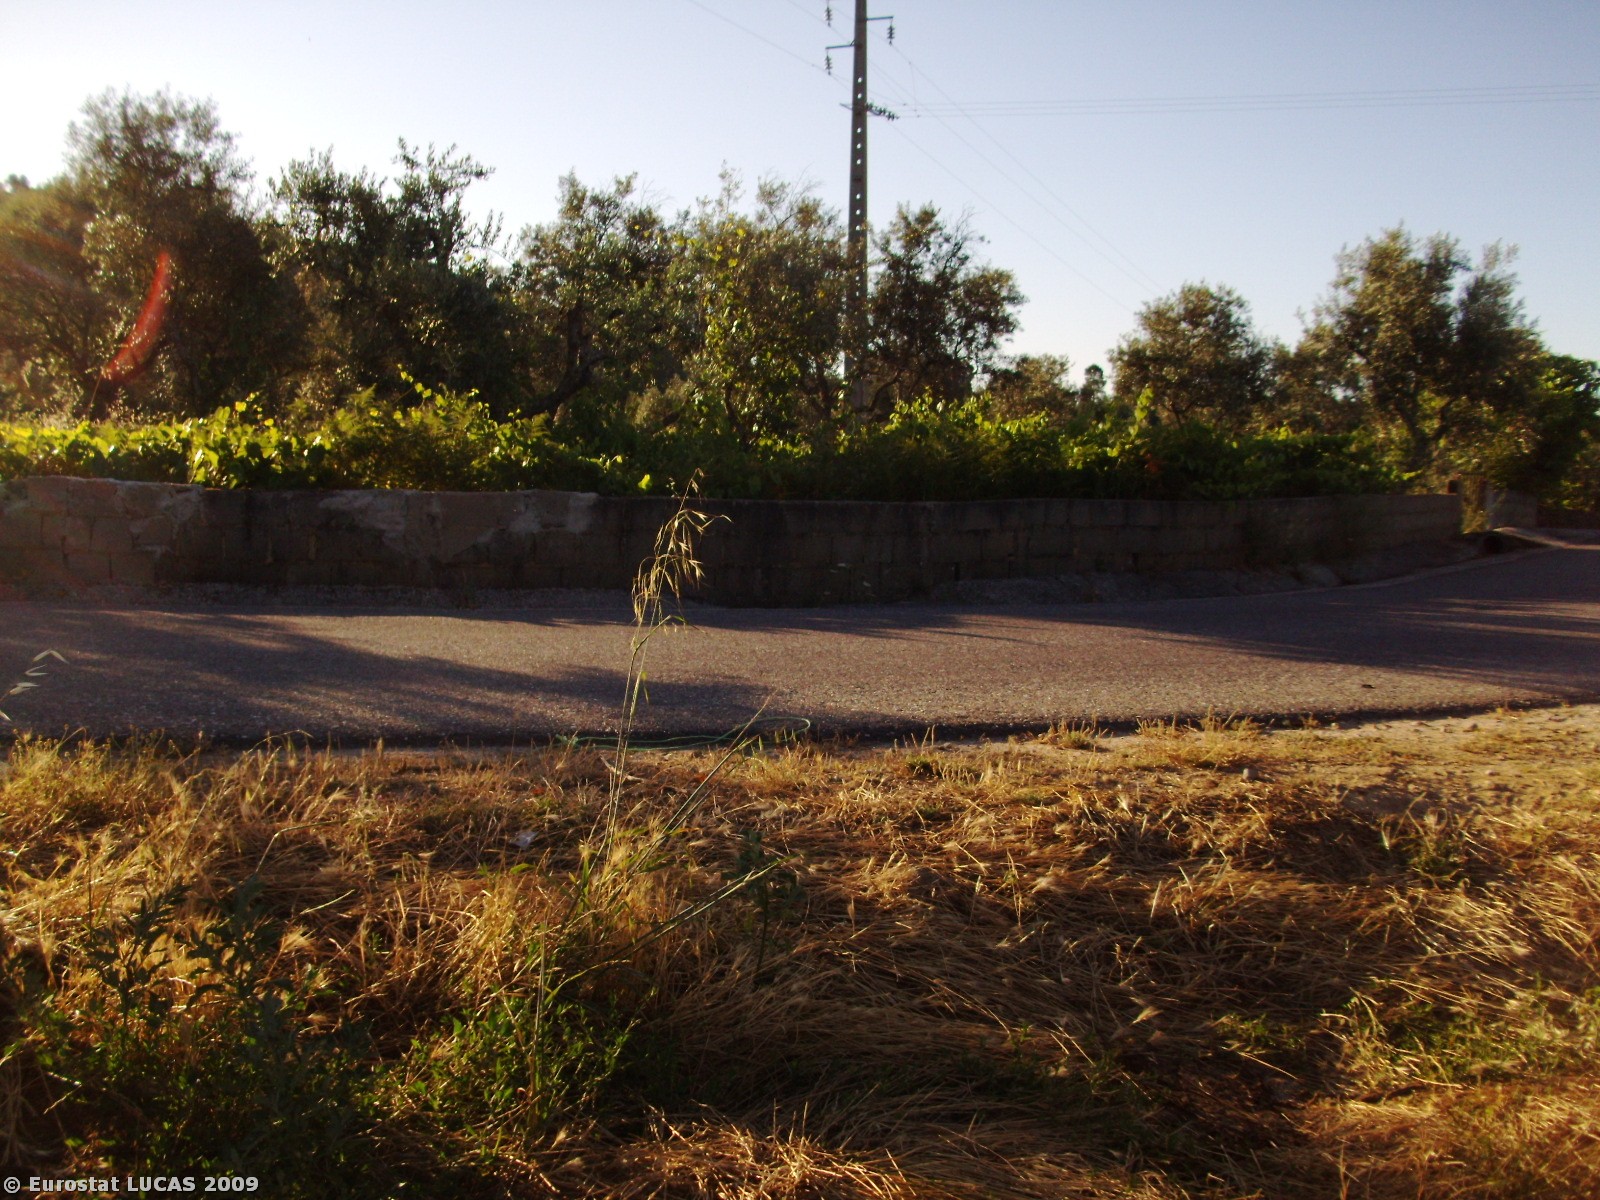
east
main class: Cropland
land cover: Olive groves
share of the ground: 50 - 75 %
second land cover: Vineyards
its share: 10 - 25 %
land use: Agriculture (excluding fallow land and kitchen gardens)
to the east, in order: Olive groves; Vineyards; Olive groves; Dry stone walls; Paved roads, cycling and walking lanes; Dry stone walls; Olive groves; Dry stone walls; Artificial constructions in urban areas; Other citrus fruit; Olive groves; Dry stone walls; Olive groves; Dry stone walls; Olive groves; Rivers and streams; Olive groves; Coniferous woodland
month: June
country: PT
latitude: 40.0366
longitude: -7.5547
